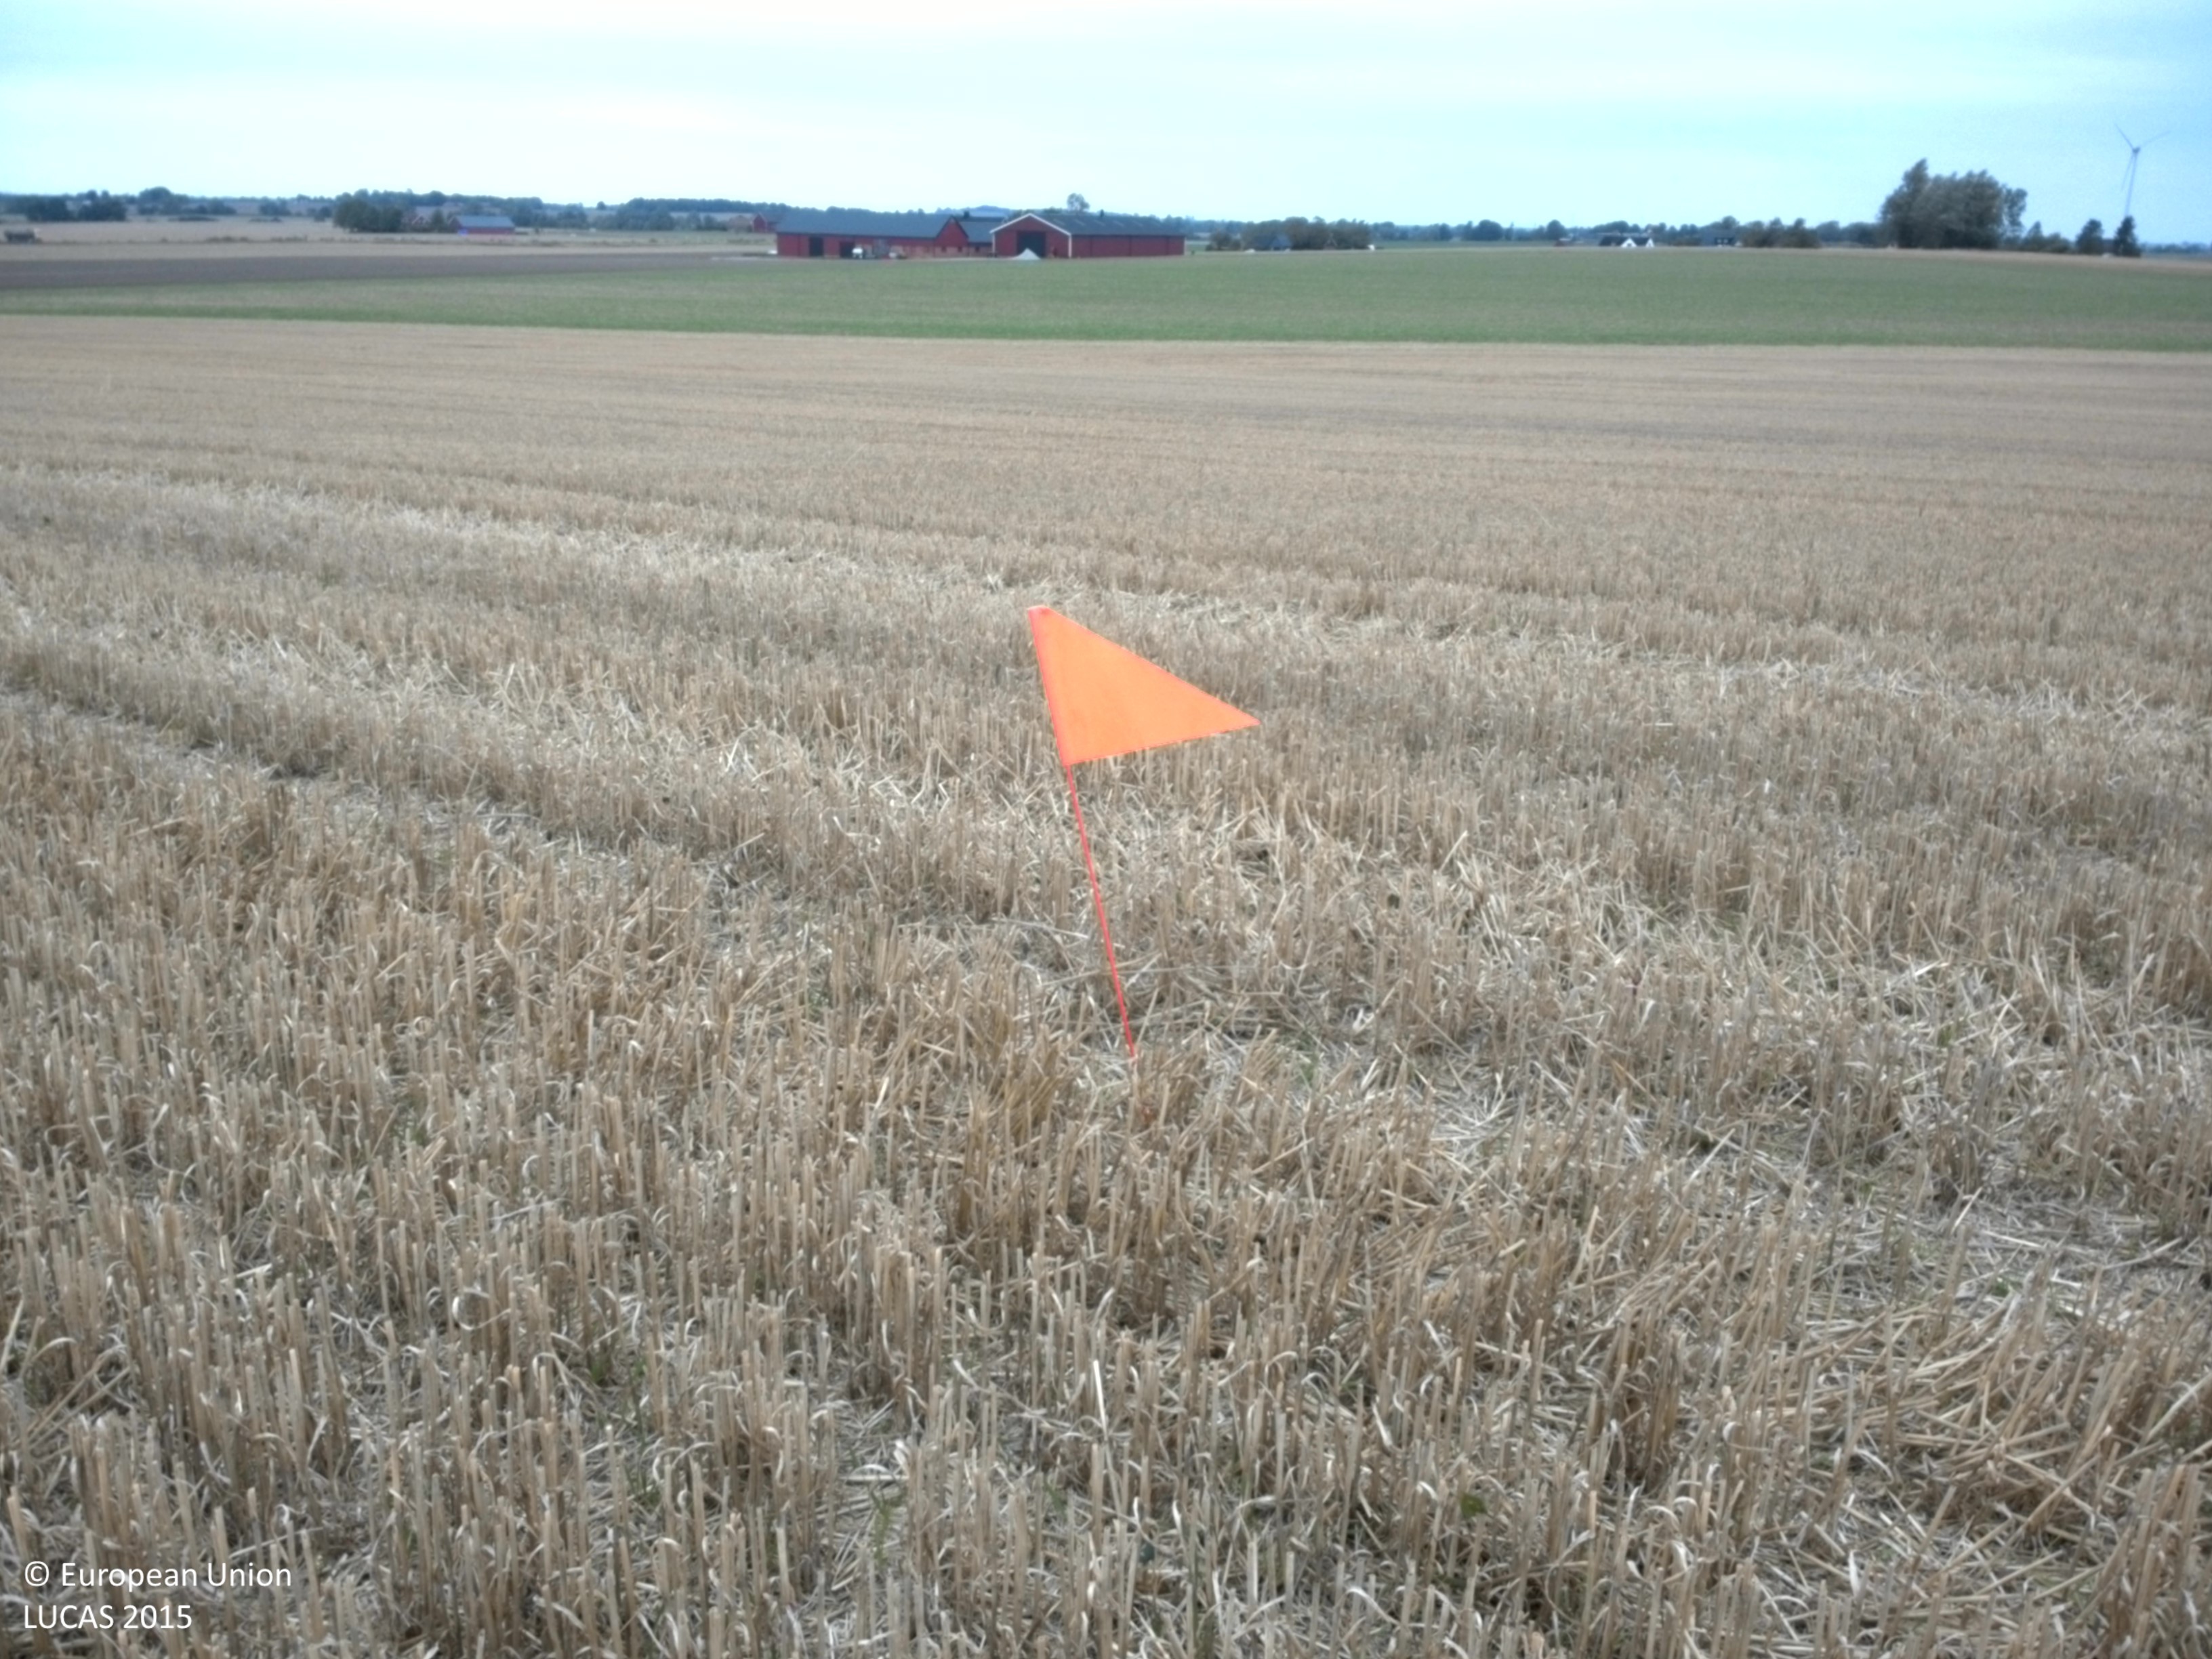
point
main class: Cropland
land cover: Common wheat
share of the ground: 25 - 50 %
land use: Agriculture (excluding fallow land and kitchen gardens)
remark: Harvested field
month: October
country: SE
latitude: 55.8794
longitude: 13.1468
